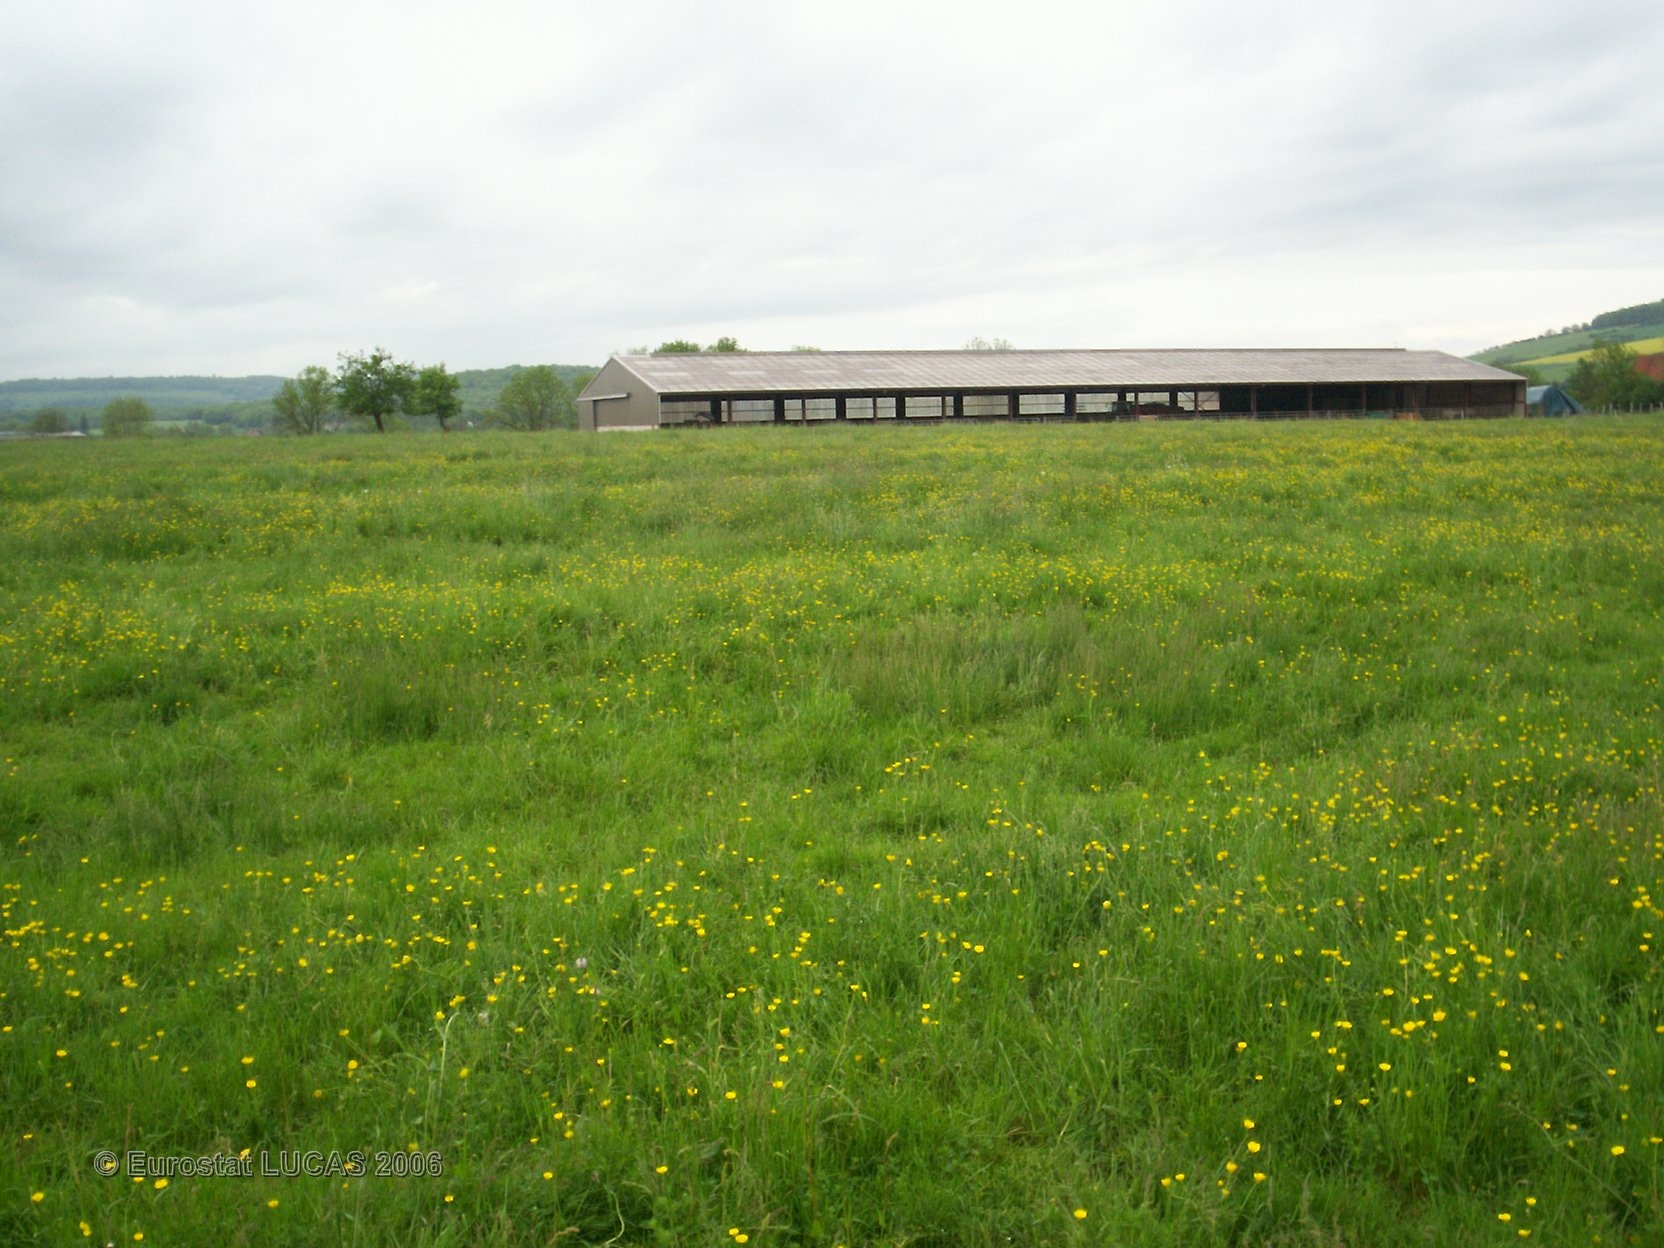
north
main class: Grassland
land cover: Grassland without tree/shrub cover
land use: Agriculture (excluding fallow land and kitchen gardens)
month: May
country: FR
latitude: 47.2087
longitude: 4.6265
